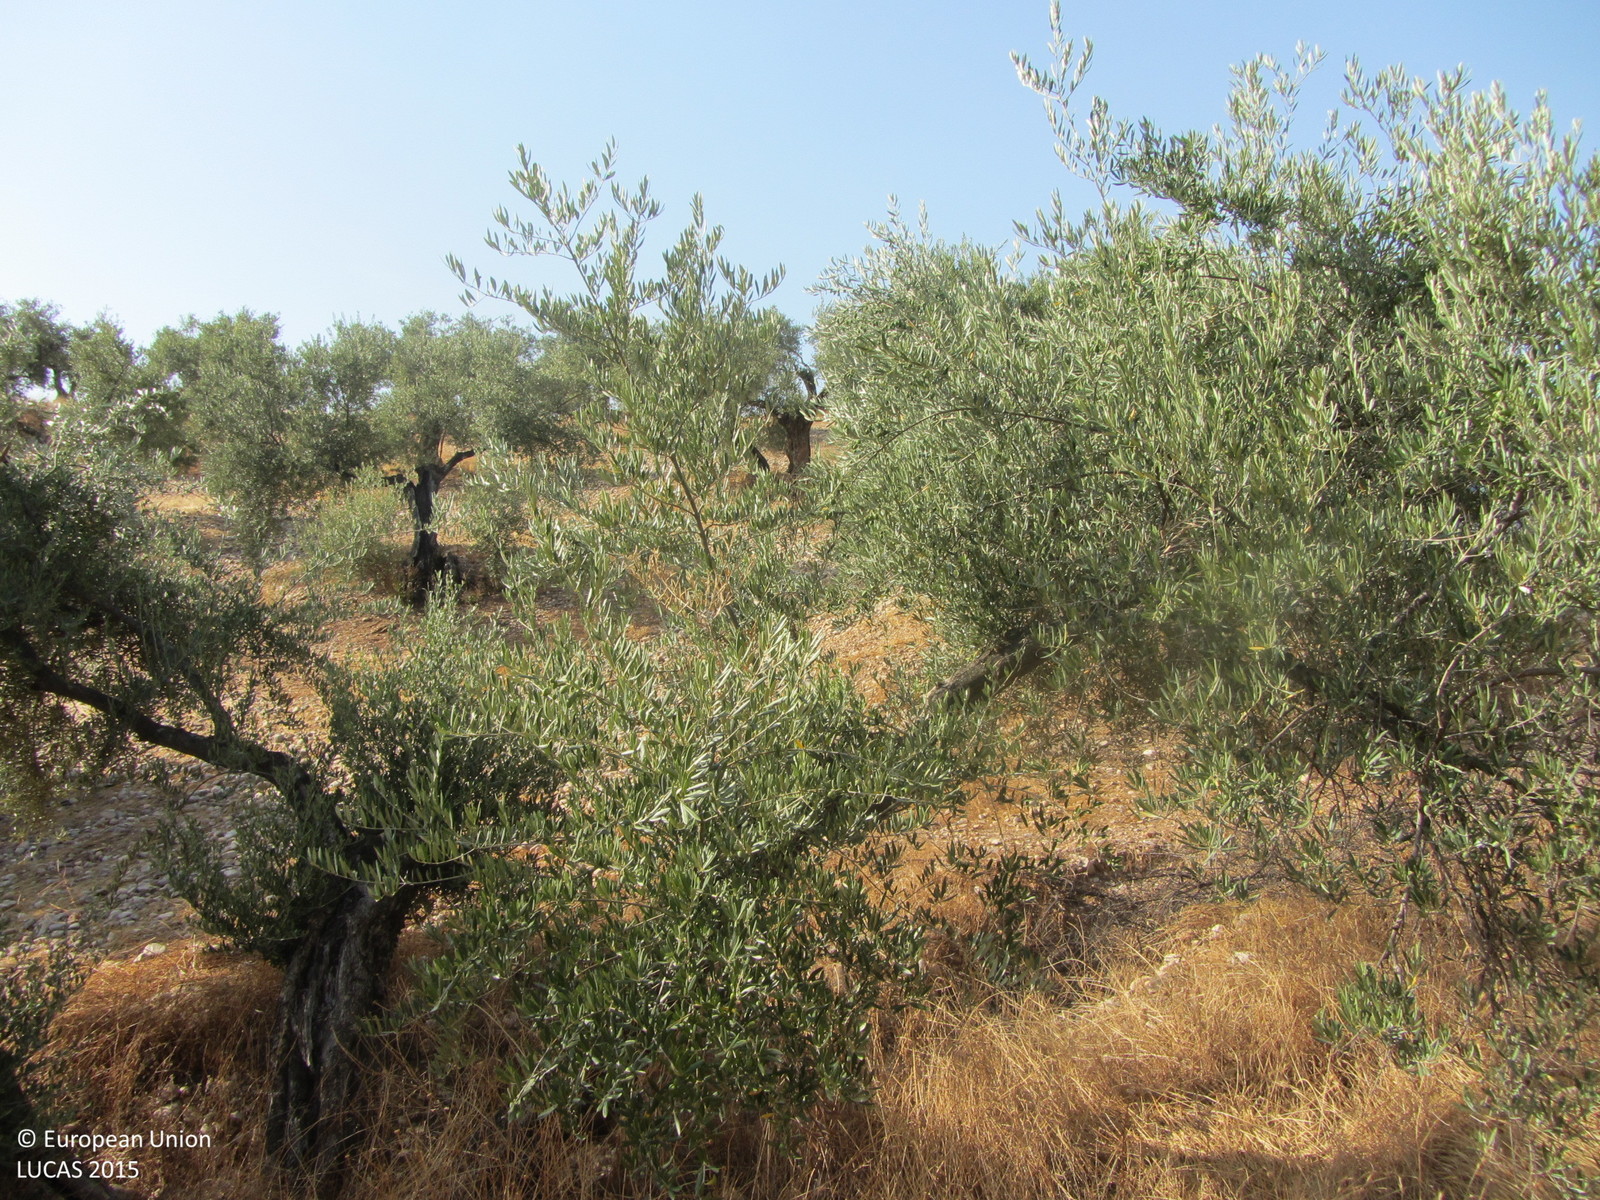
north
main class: Cropland
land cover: Olive groves
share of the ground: 25 - 50 %
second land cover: Spontaneously vegetated surfaces
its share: 50 - 75 %
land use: Agriculture (excluding fallow land and kitchen gardens)
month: July
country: ES
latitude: 38.0506
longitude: -3.8515
